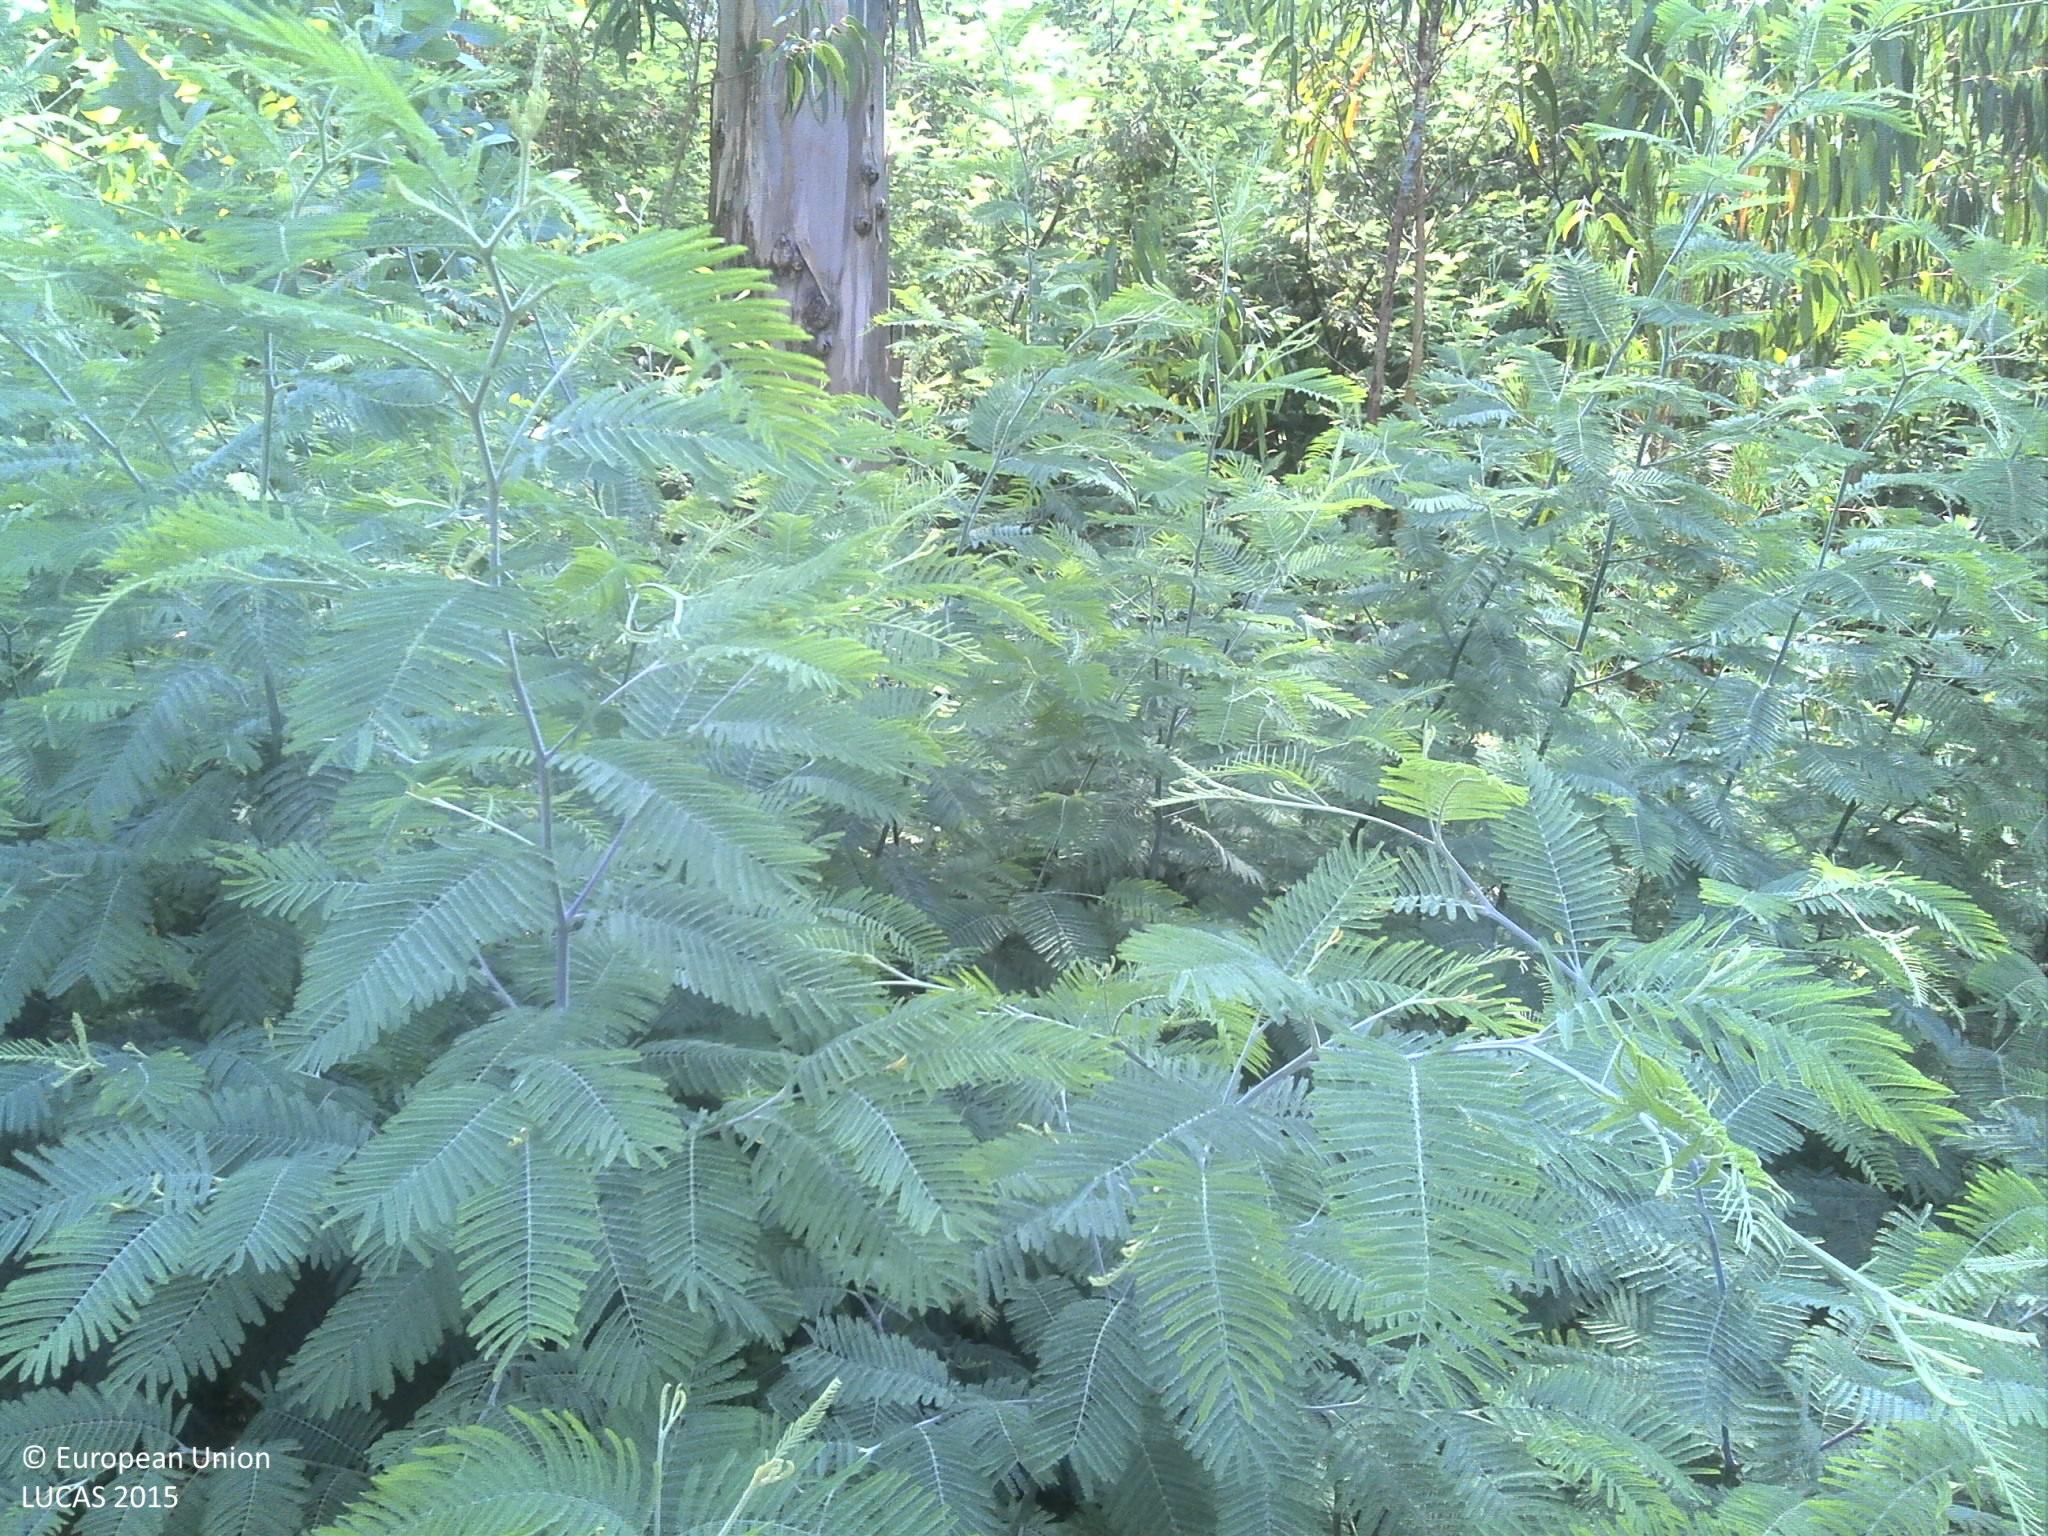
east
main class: Woodland
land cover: Broadleaved woodland
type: exotic forest
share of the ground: > 75 %
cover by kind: broadleaved forest trees 85 %, shrubs 10 %, unconsolidated bare surface 5 %
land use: Forestry
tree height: > 5 m
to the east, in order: Broadleaved woodland; Dry stone walls; Rivers and streams; Dry stone walls; Broadleaved woodland; Tracks; Broadleaved woodland; Shrubland with sparse tree cover; Shrubland without tree cover
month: June
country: PT
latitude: 41.1252
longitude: -8.1605
